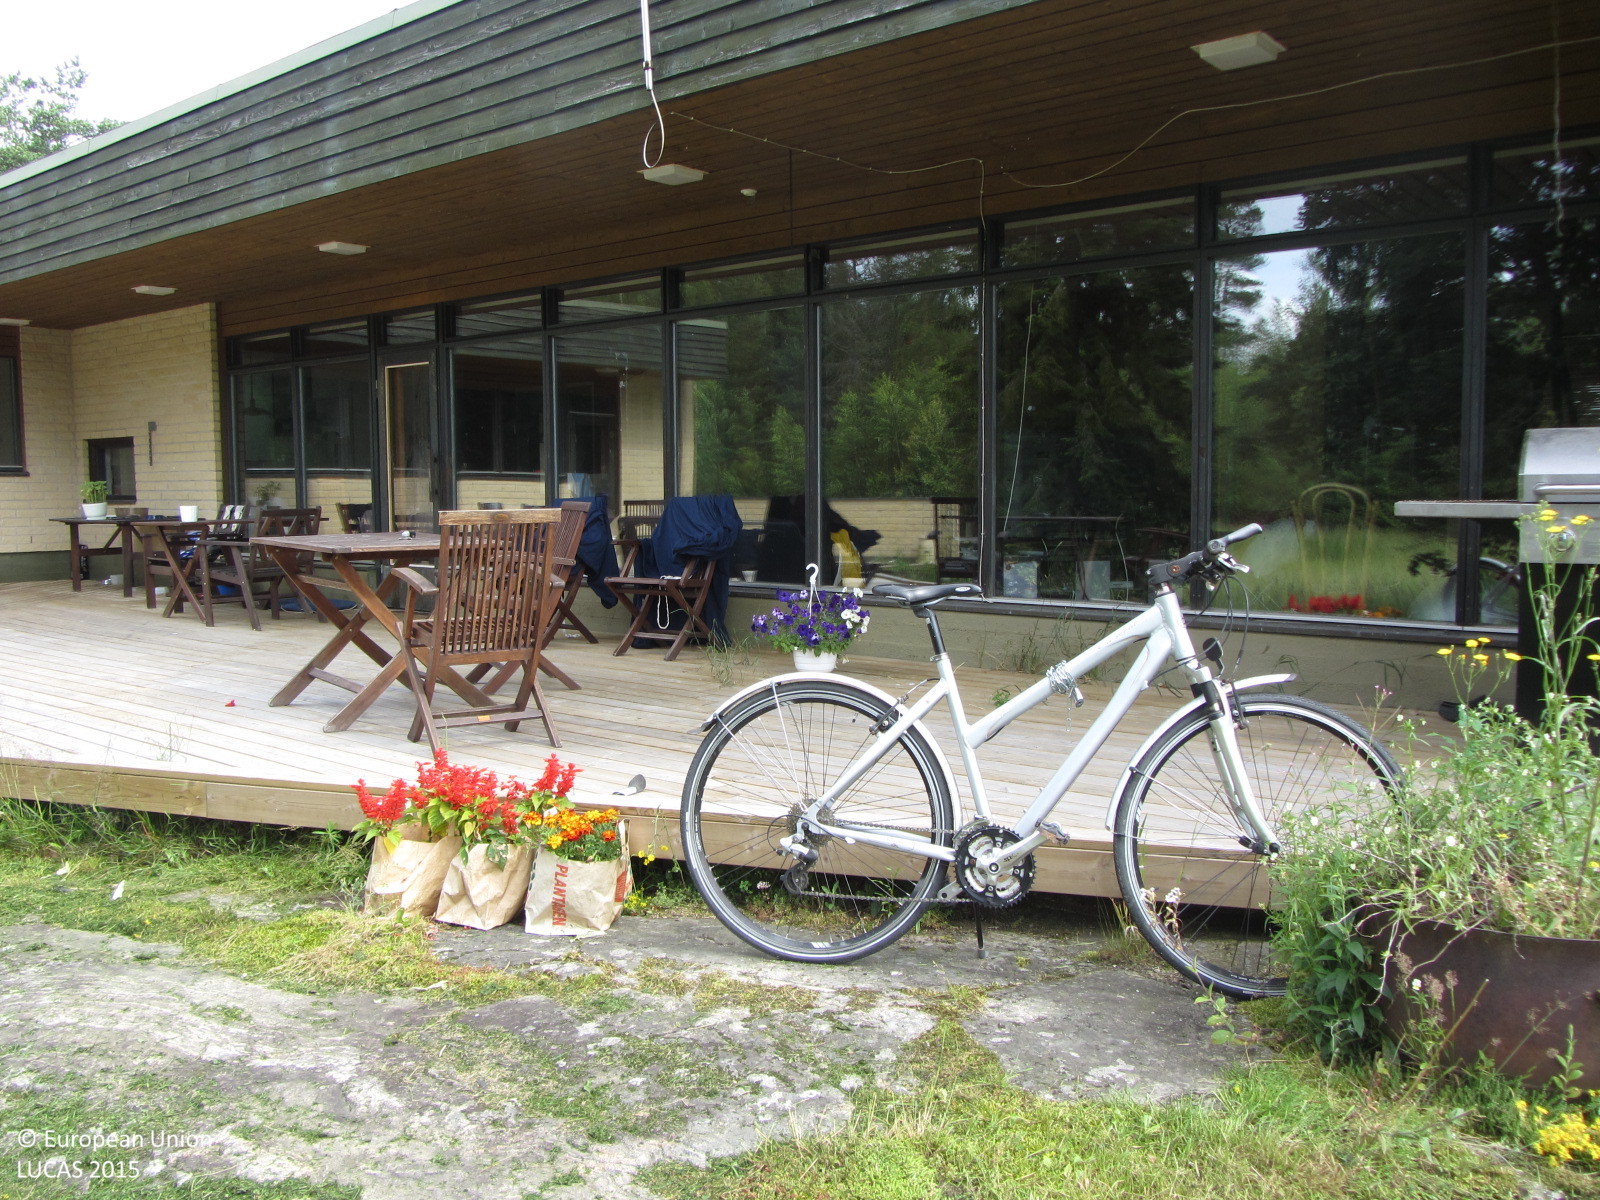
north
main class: Grassland
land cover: Grassland with sparse tree/shrub cover
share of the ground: > 75 %
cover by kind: herbaceous plants 85 %, shrubs 10 %, broadleaved forest trees 5 %
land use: Residential
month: July
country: FI
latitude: 60.0724
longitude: 24.0992
